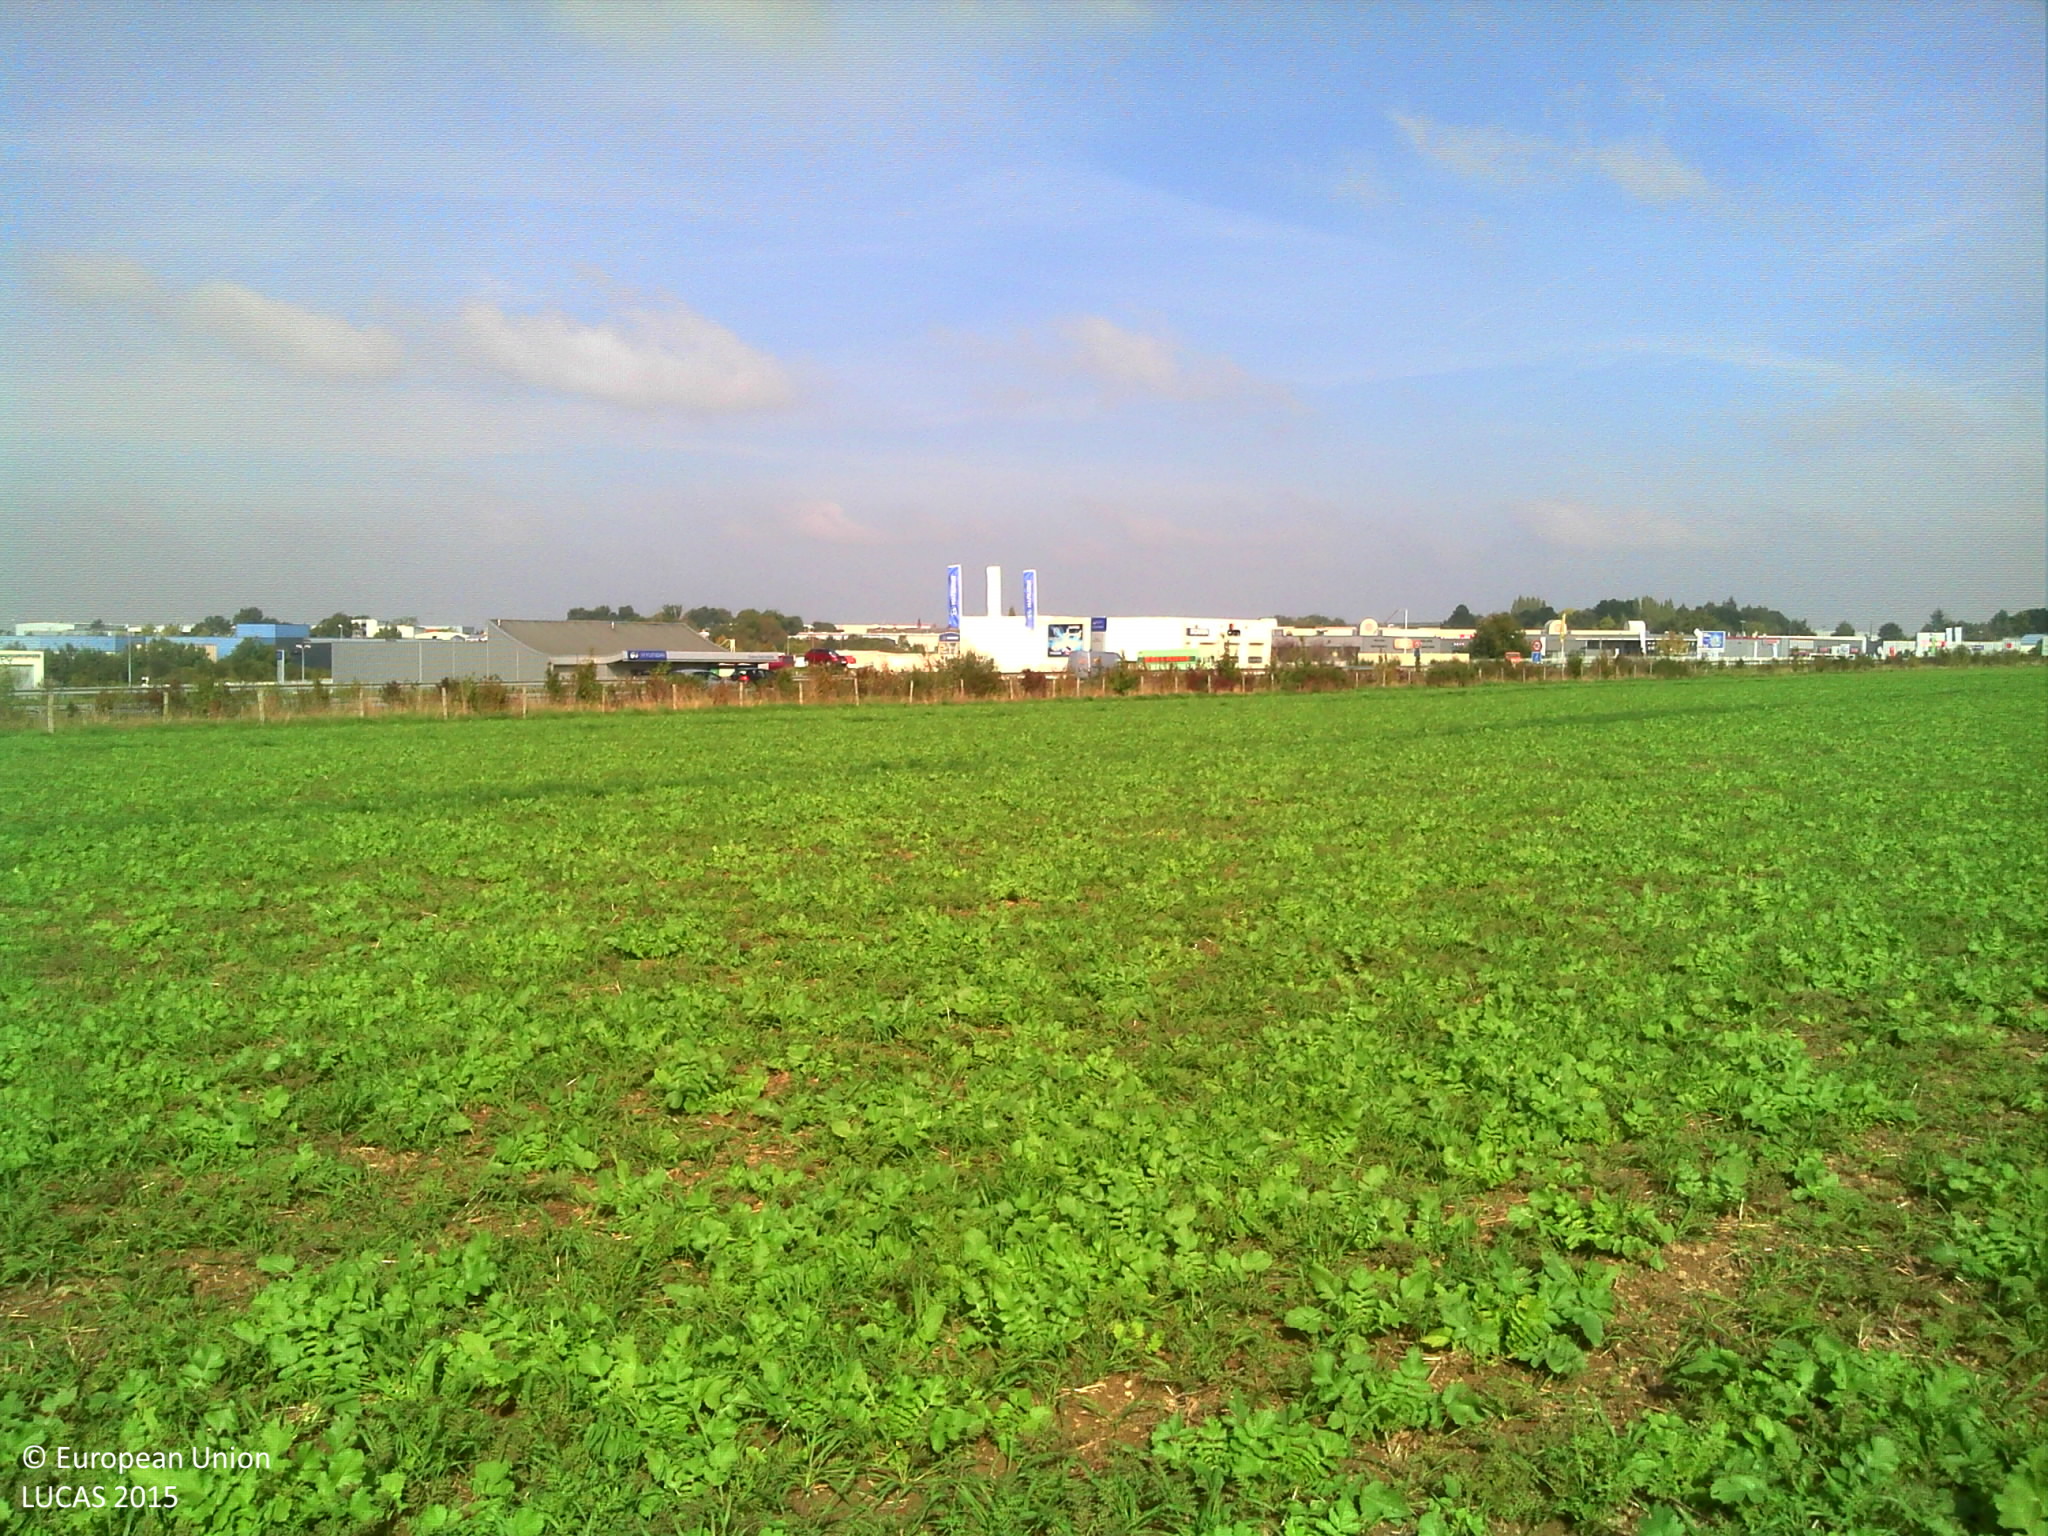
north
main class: Grassland
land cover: Spontaneously vegetated surfaces
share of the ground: > 75 %
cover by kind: herbaceous plants 95 %, unconsolidated bare surface 5 %
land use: Agriculture (excluding fallow land and kitchen gardens)
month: October
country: FR
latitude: 47.0262
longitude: -0.9148
